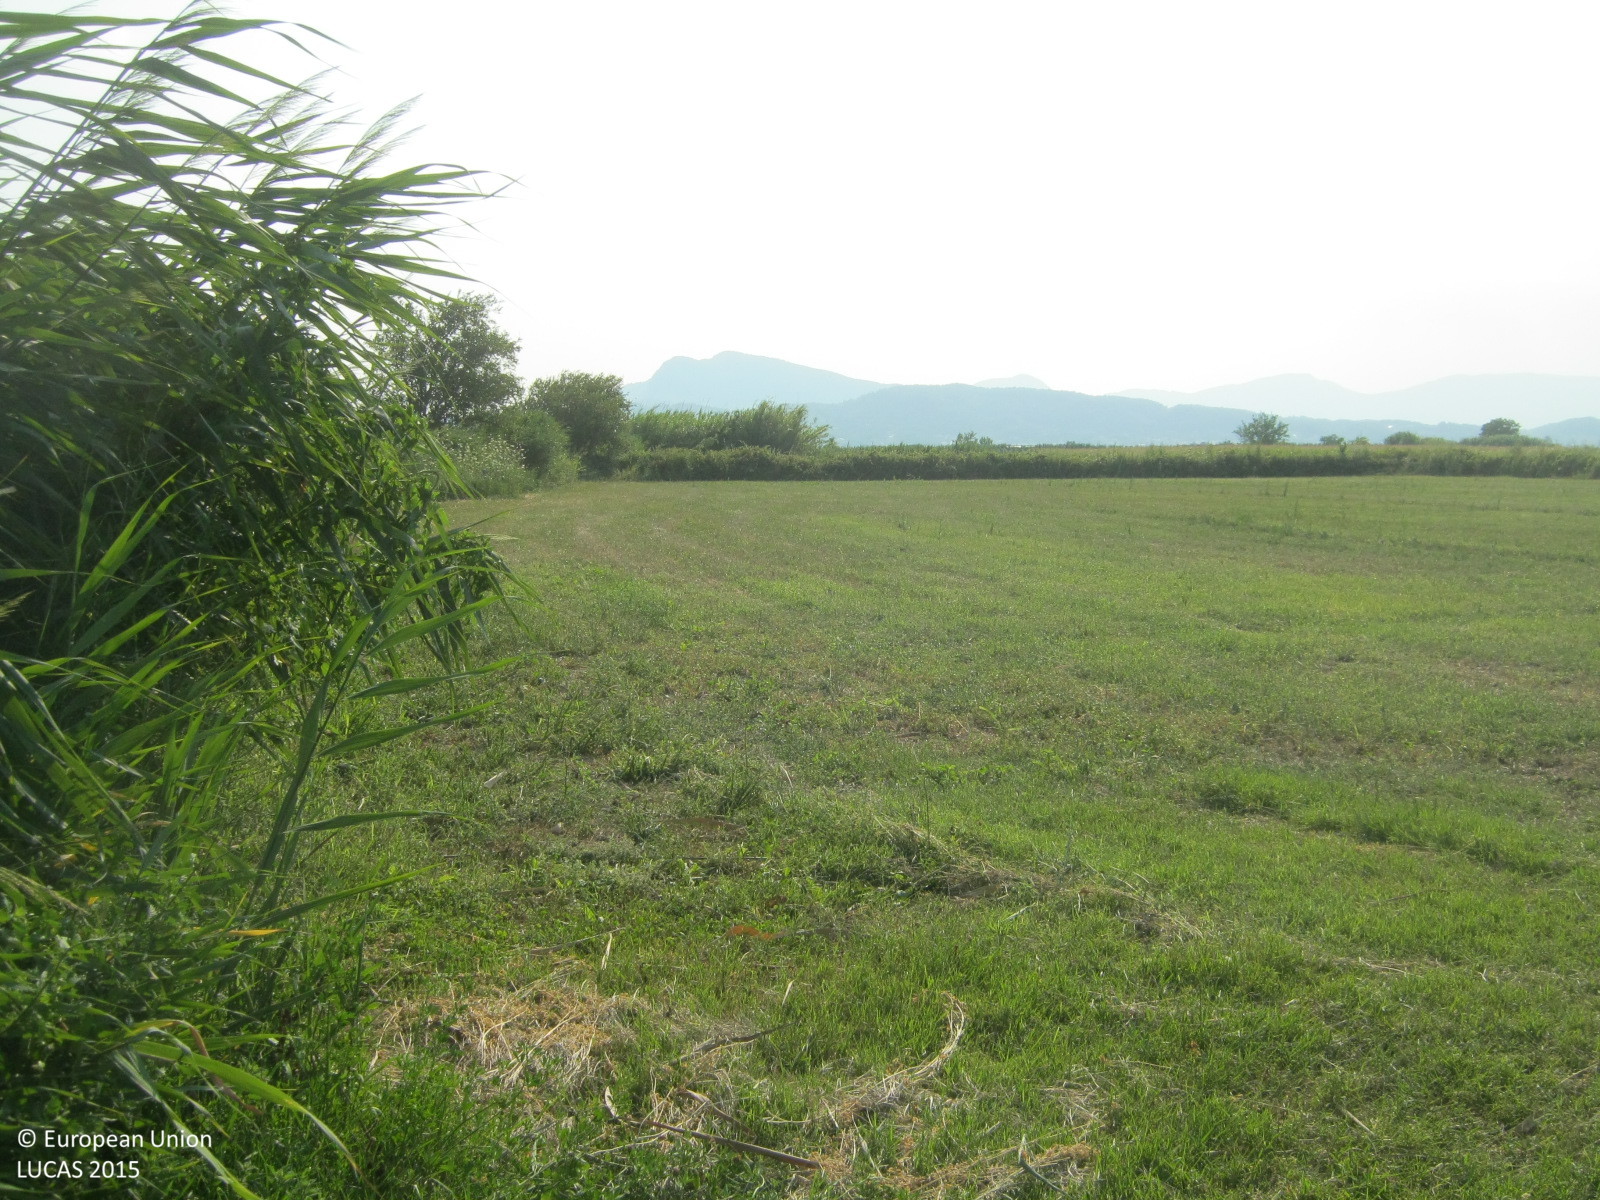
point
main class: Cropland
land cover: Clovers
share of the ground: > 75 %
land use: Agriculture (excluding fallow land and kitchen gardens)
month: July
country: GR
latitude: 39.1975
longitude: 20.9392
